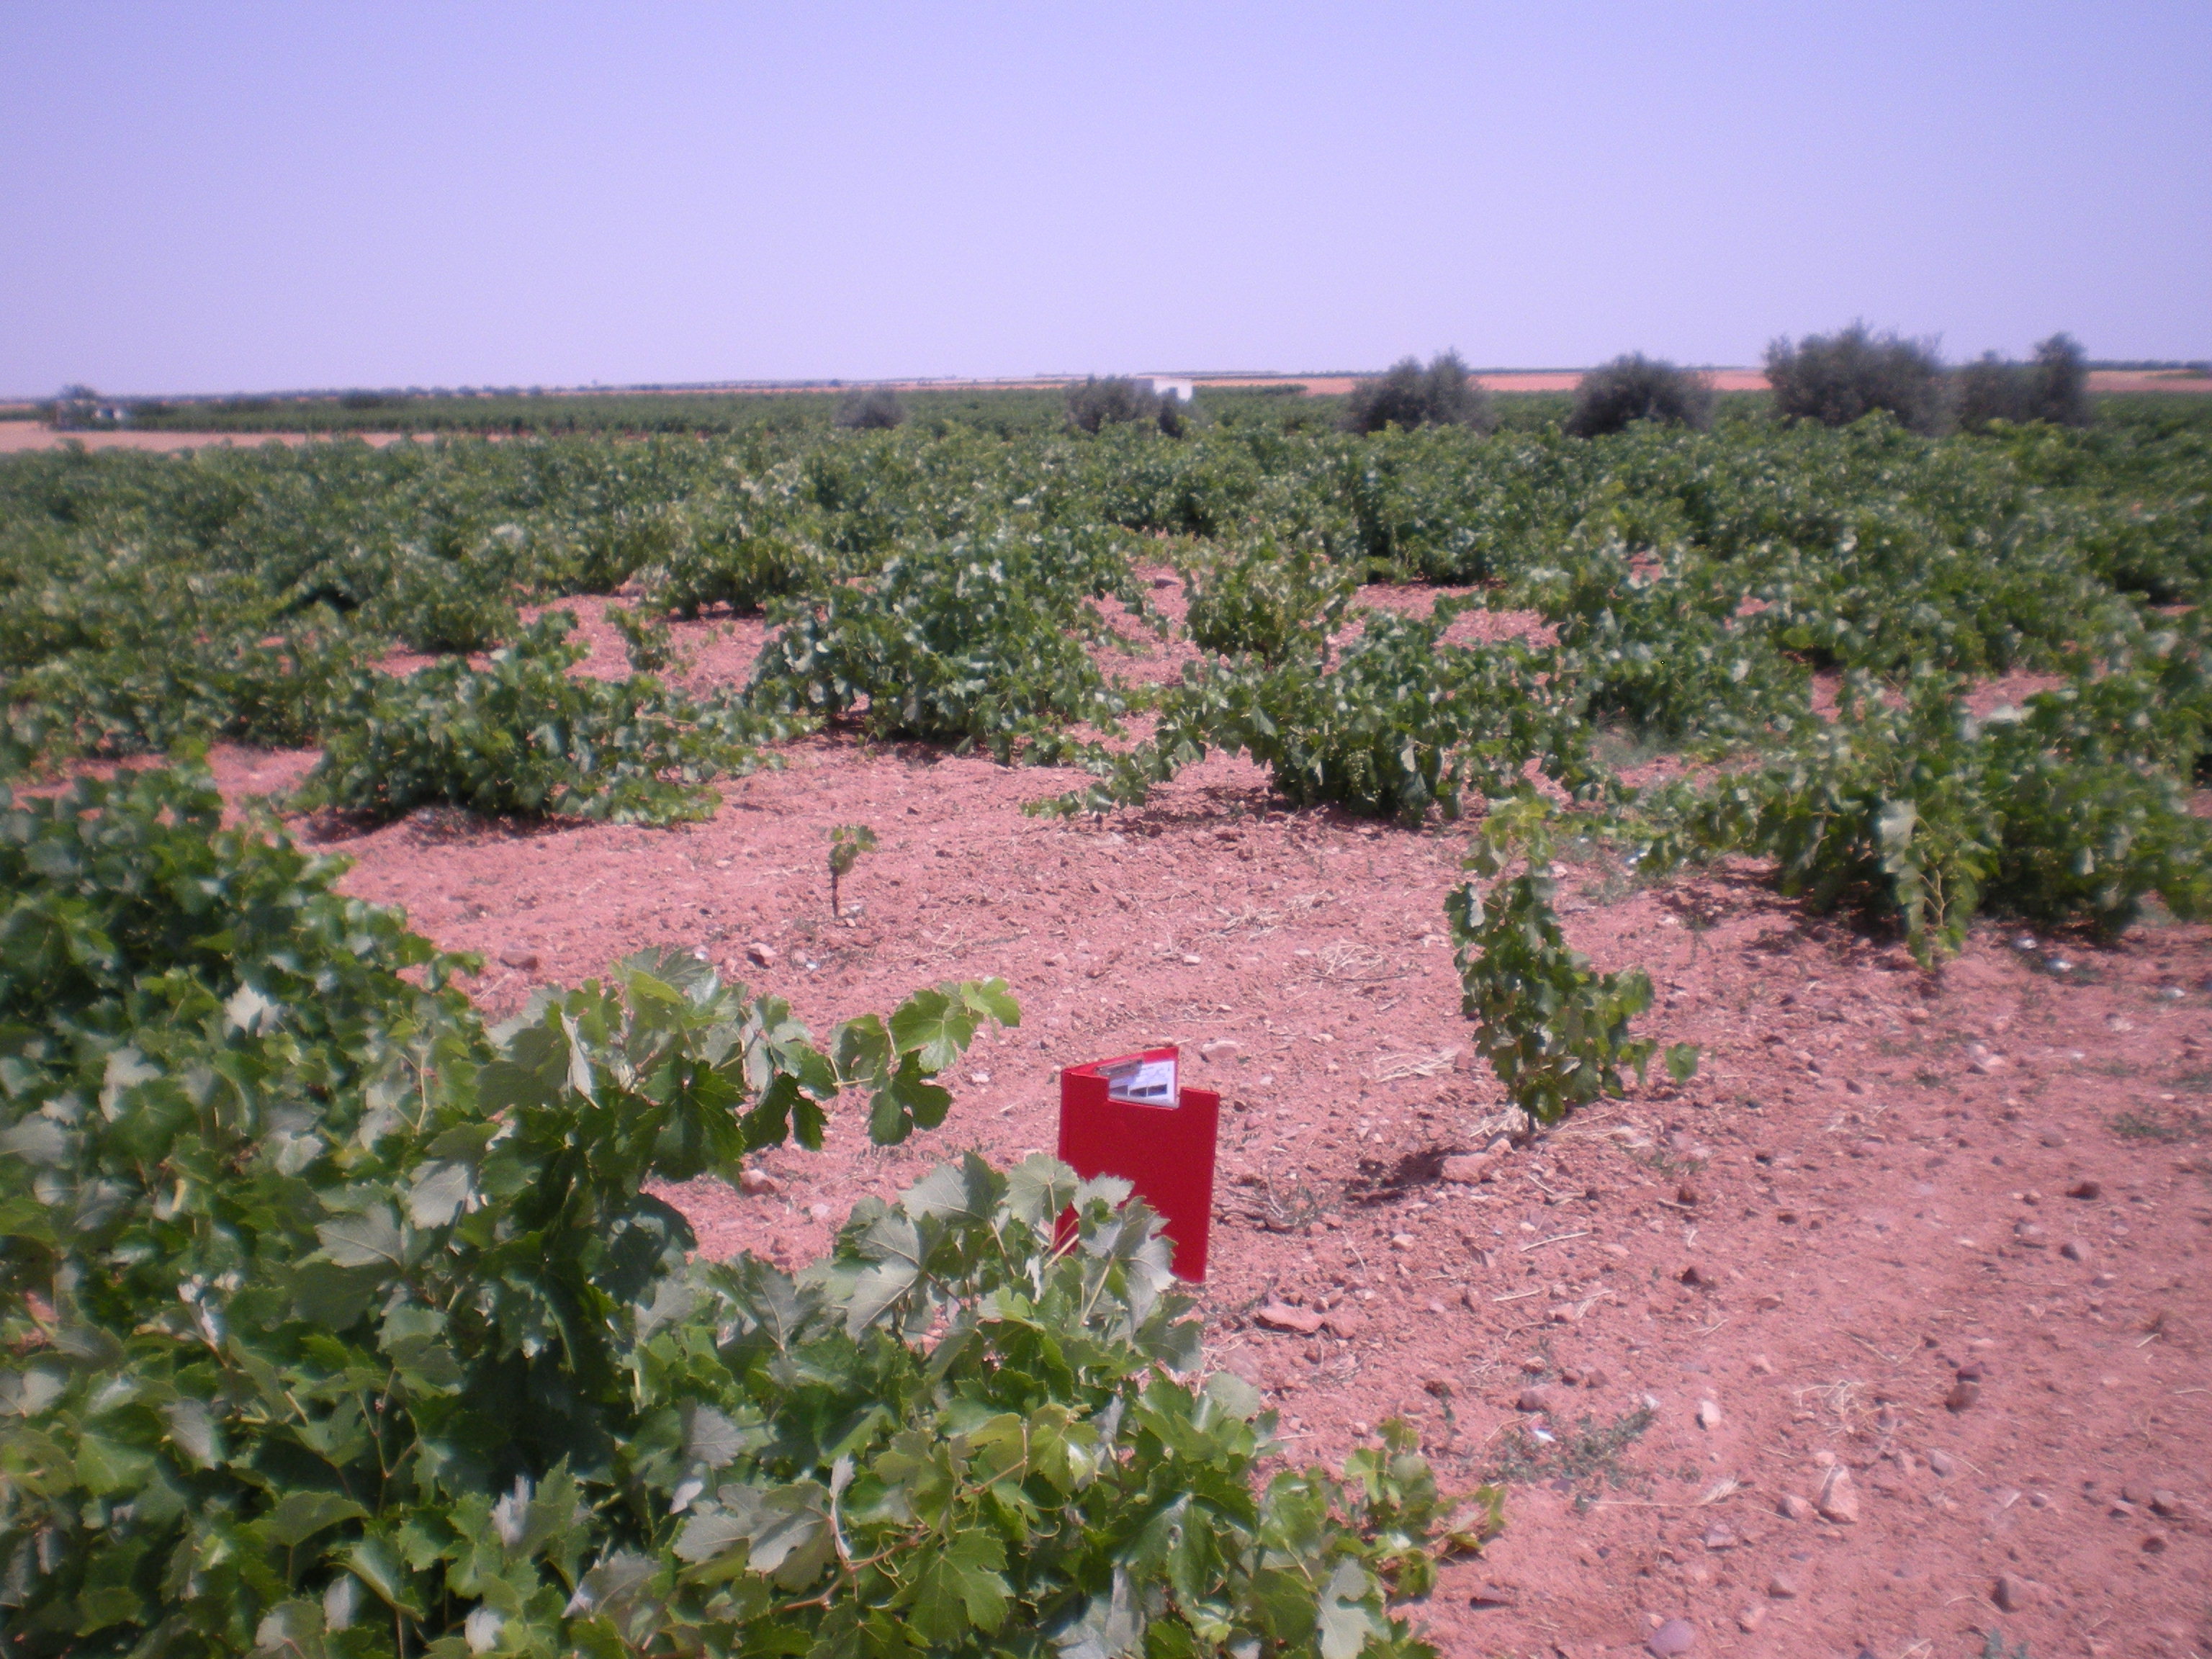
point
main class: Cropland
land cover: Vineyards
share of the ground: 10 - 25 %
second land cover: Spontaneously vegetated surfaces
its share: 10 - 25 %
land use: Agriculture (excluding fallow land and kitchen gardens)
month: July
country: ES
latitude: 39.4570
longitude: -3.3741
